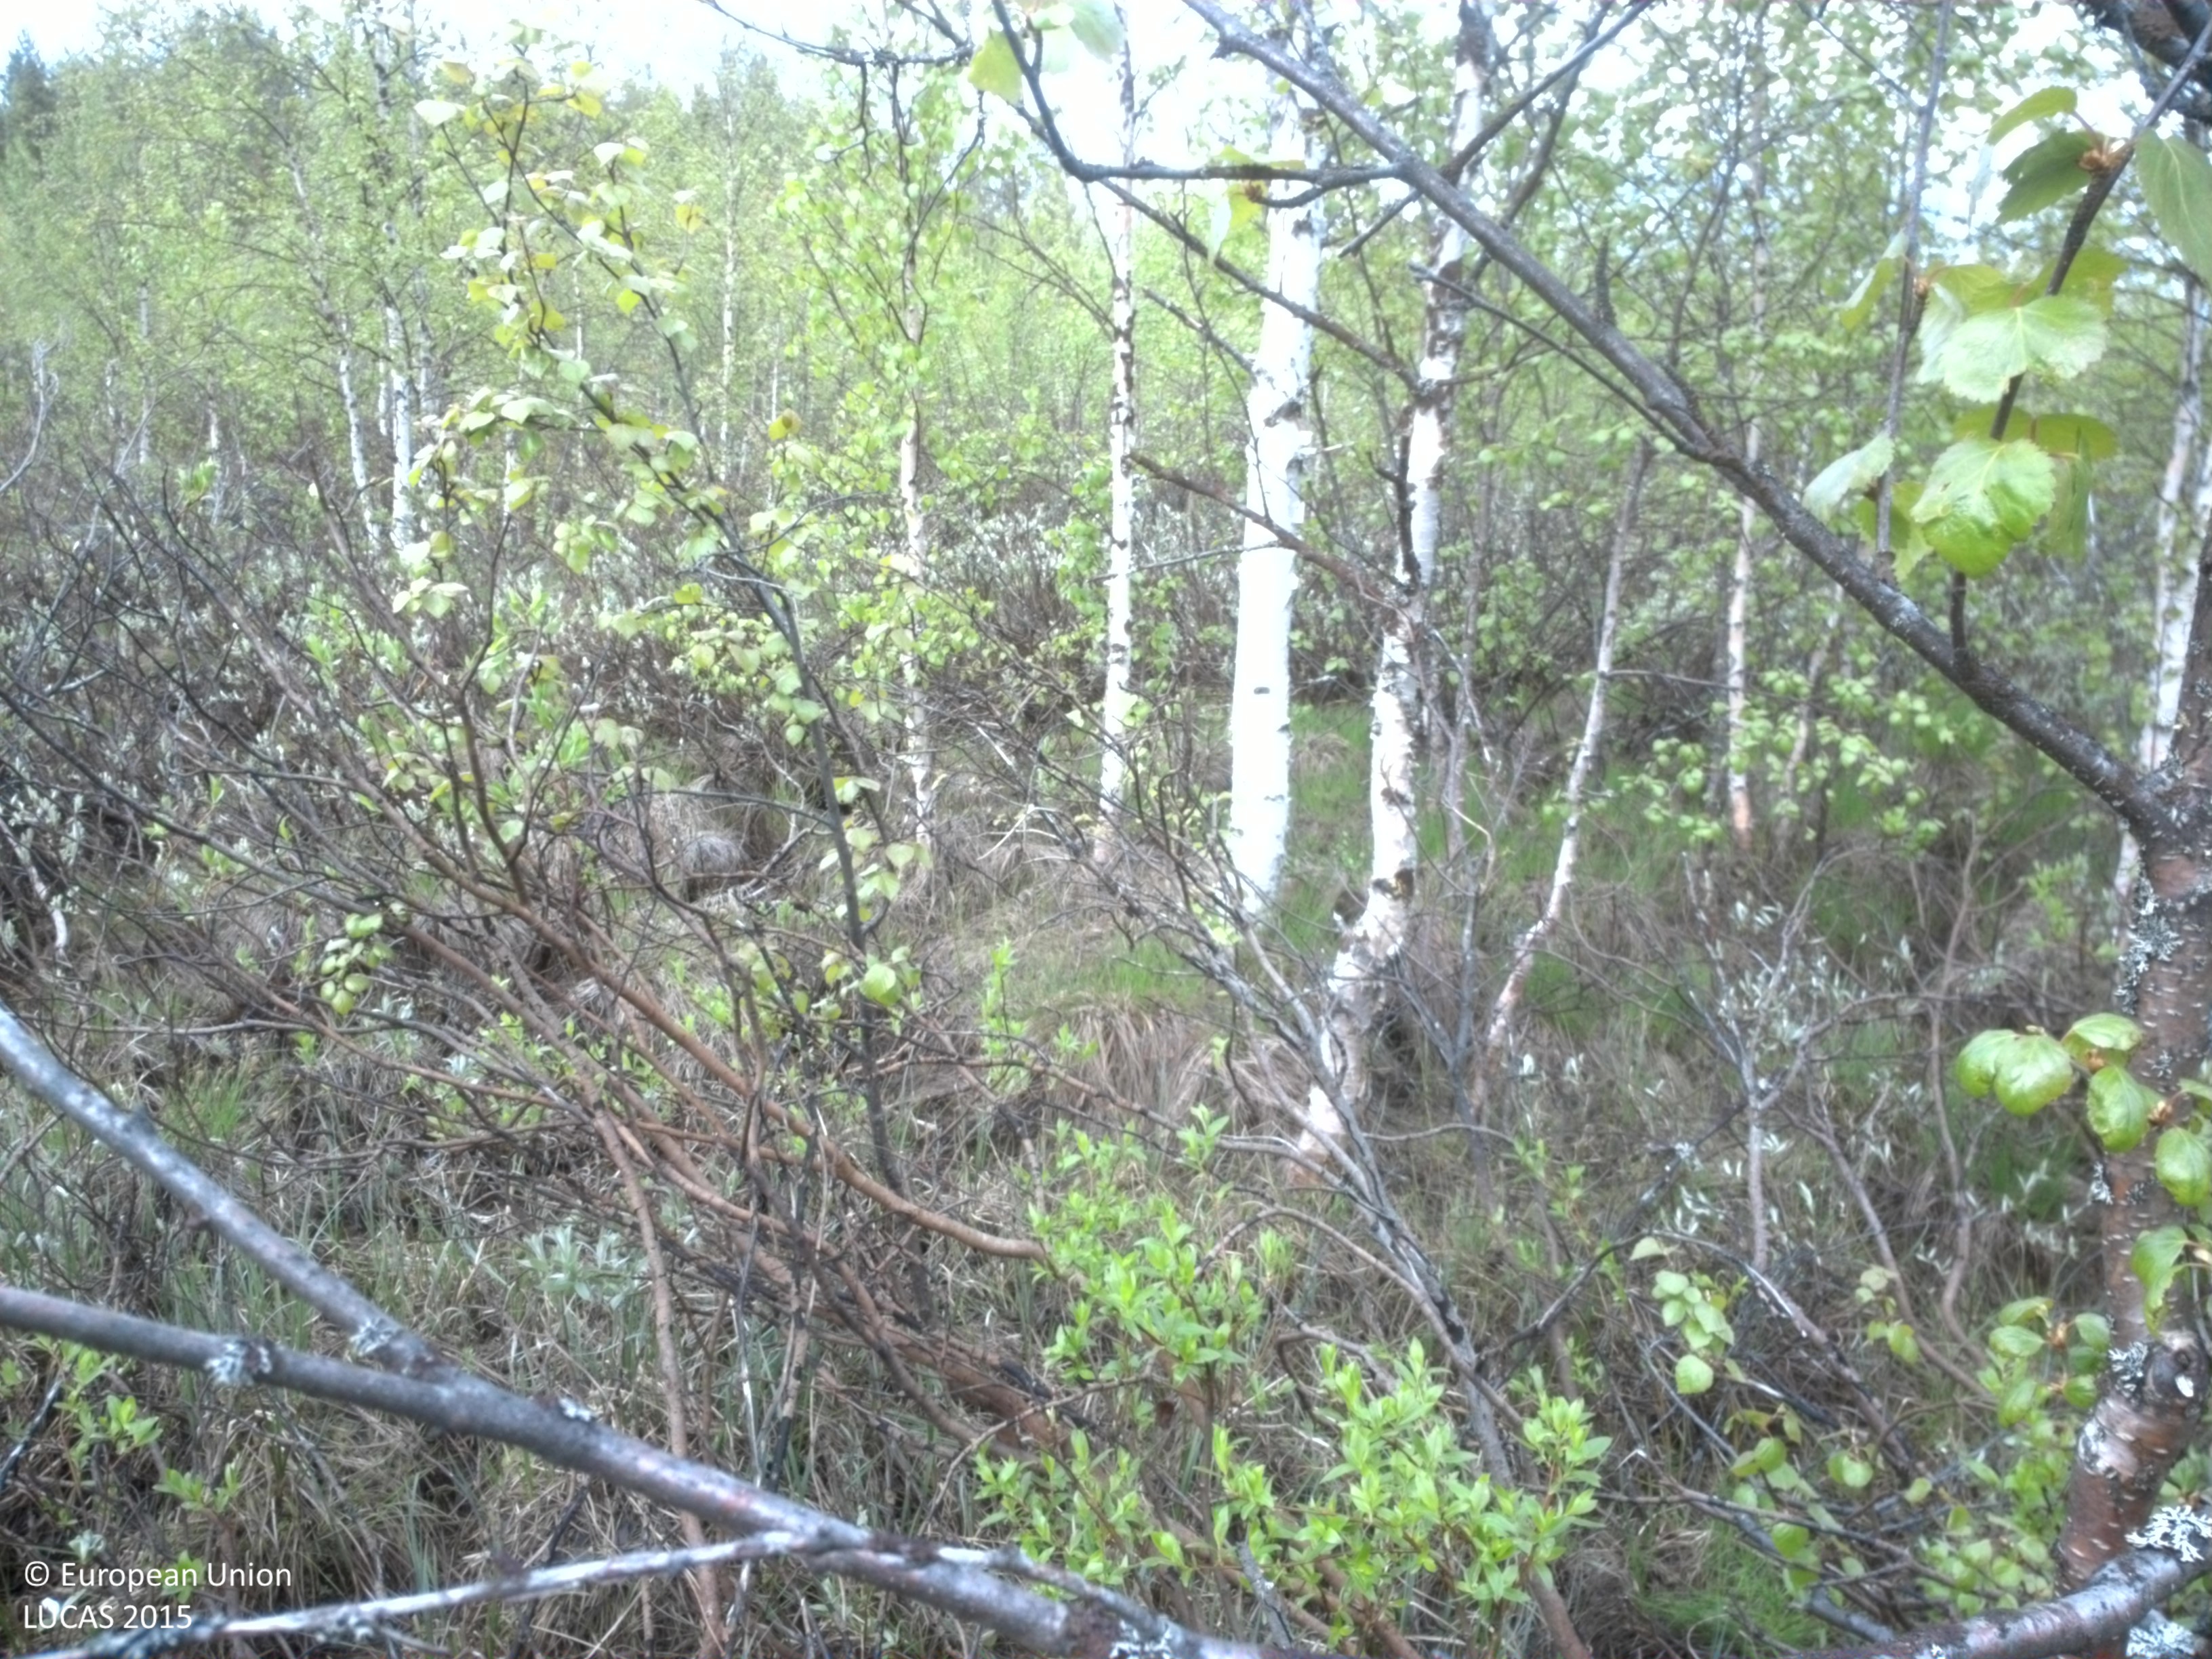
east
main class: Woodland
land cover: Broadleaved woodland
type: boreal forest
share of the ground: 25 - 50 %
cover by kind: shrubs 55 %, broadleaved forest trees 40 %, herbaceous plants 5 %
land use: Semi-natural and natural areas not in use
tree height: > 5 m
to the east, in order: Broadleaved woodland; Shrubland with sparse tree cover; Broadleaved woodland; Grass margins; Shrubland with sparse tree cover; Rivers and streams; Shrubland with sparse tree cover; Broadleaved woodland; Shrubland with sparse tree cover; Grassland without tree/shrub cover; Artificial constructions in urban areas
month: June
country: SE
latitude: 67.0127
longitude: 21.8681
